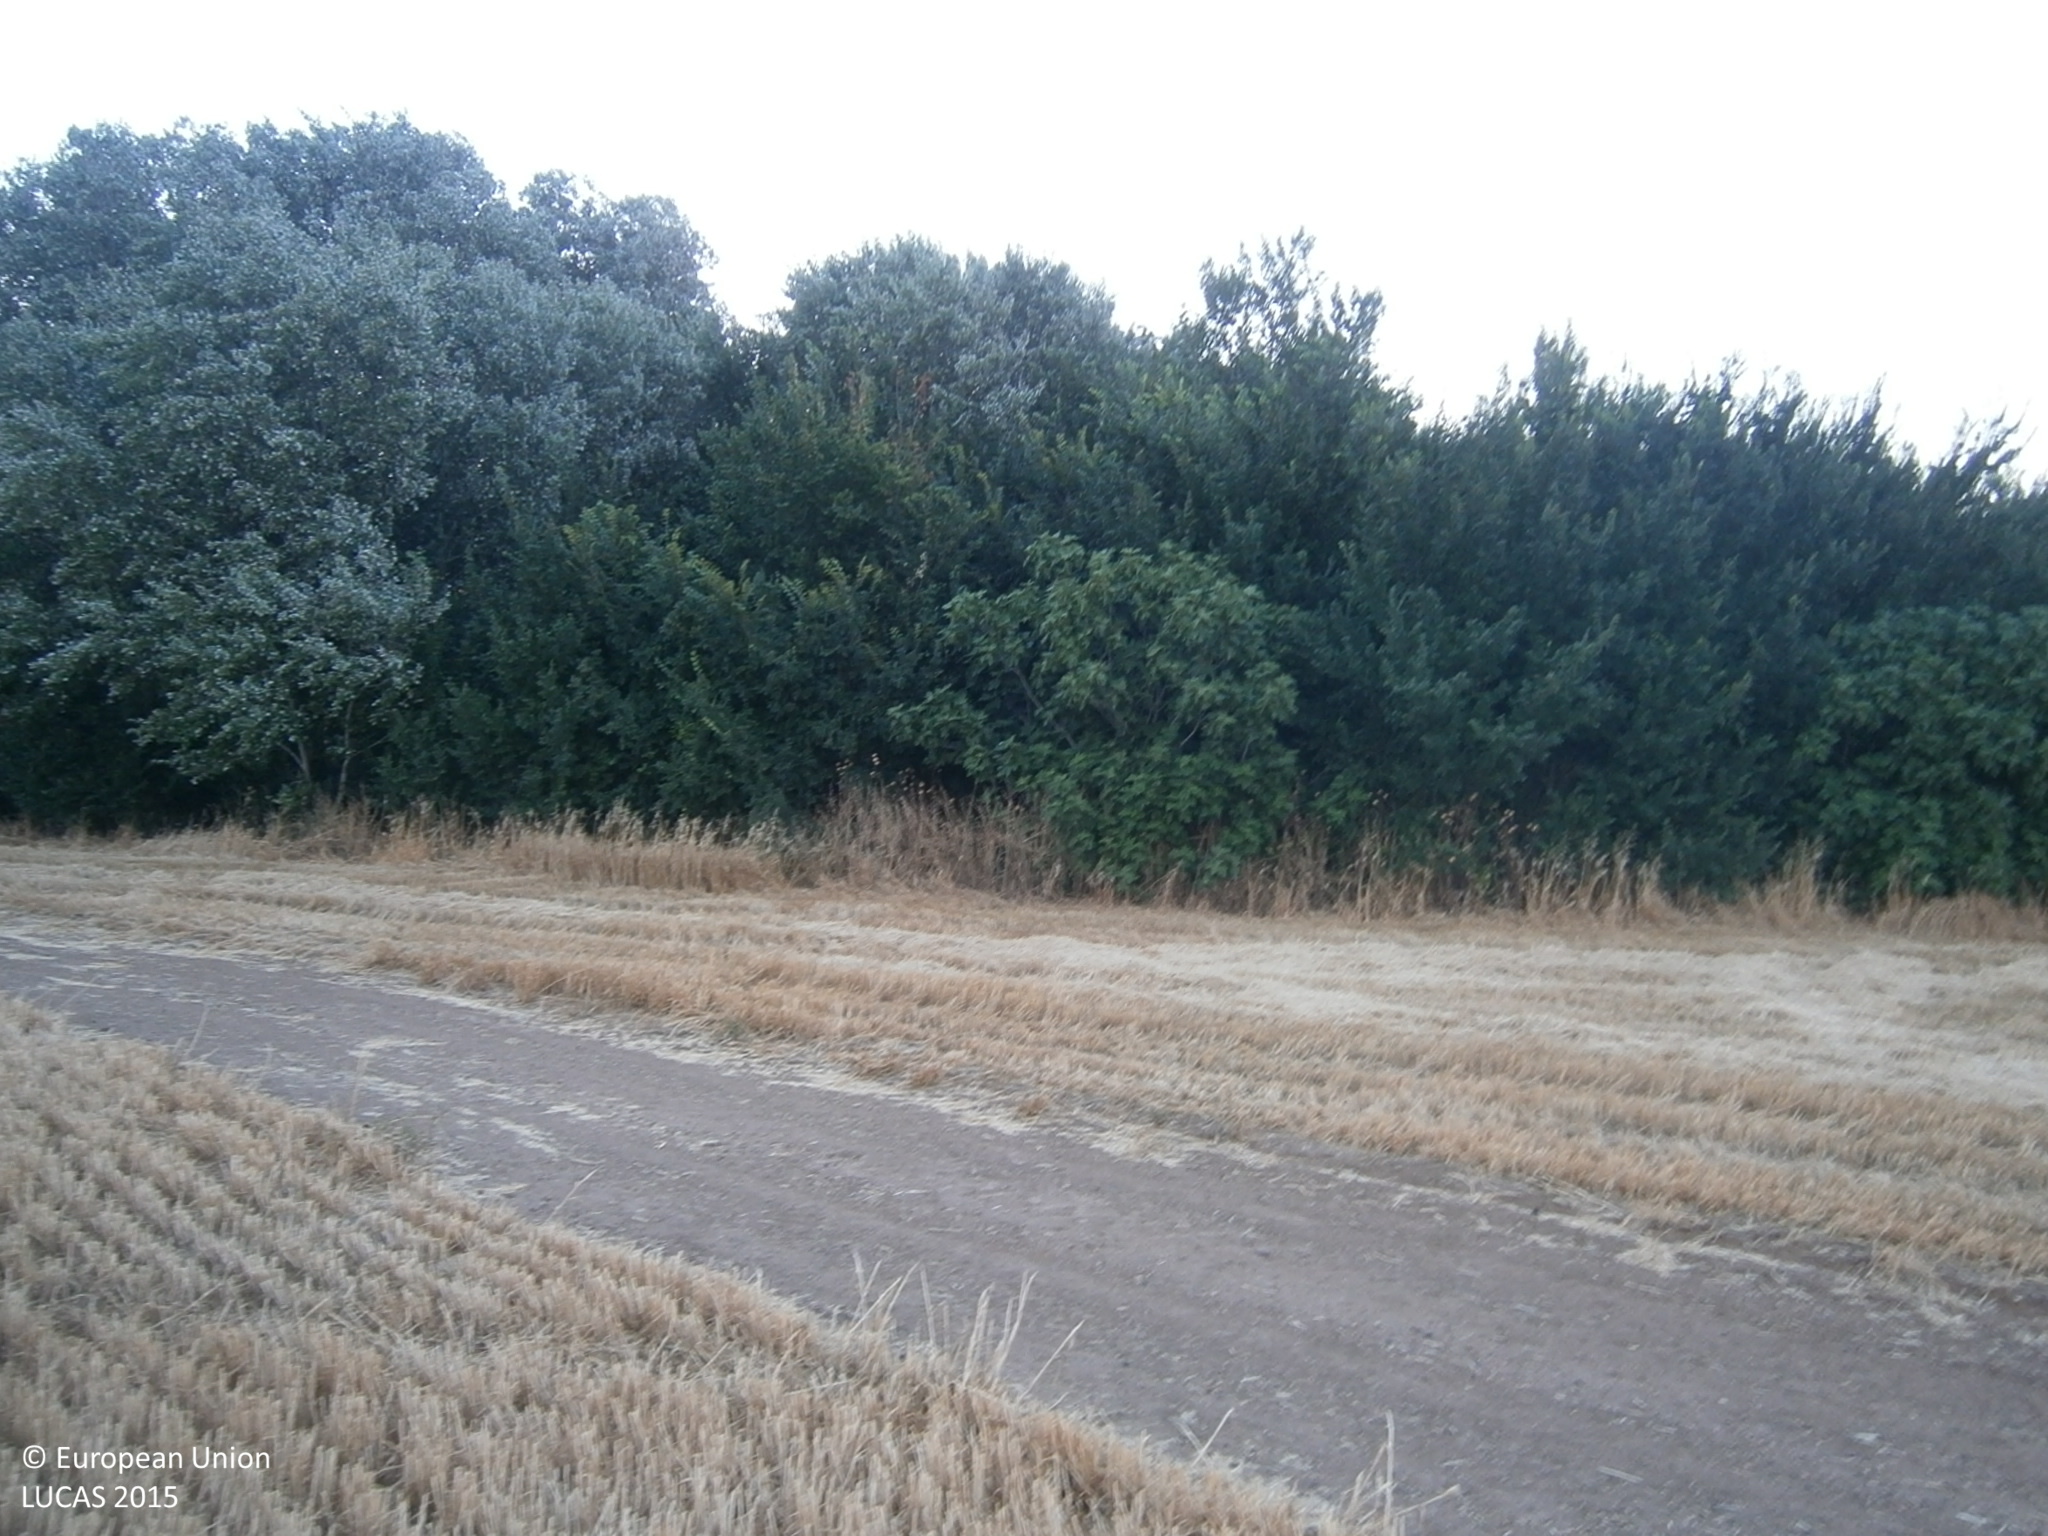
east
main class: Cropland
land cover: Rape and turnip rape
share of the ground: > 75 %
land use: Agriculture (excluding fallow land and kitchen gardens)
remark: Harvested field
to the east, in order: Rape and turnip rape; Tracks; Rape and turnip rape; Other mixed woodland; Rivers and streams; Barley
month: June
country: ES
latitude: 38.7426
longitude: -6.8508
